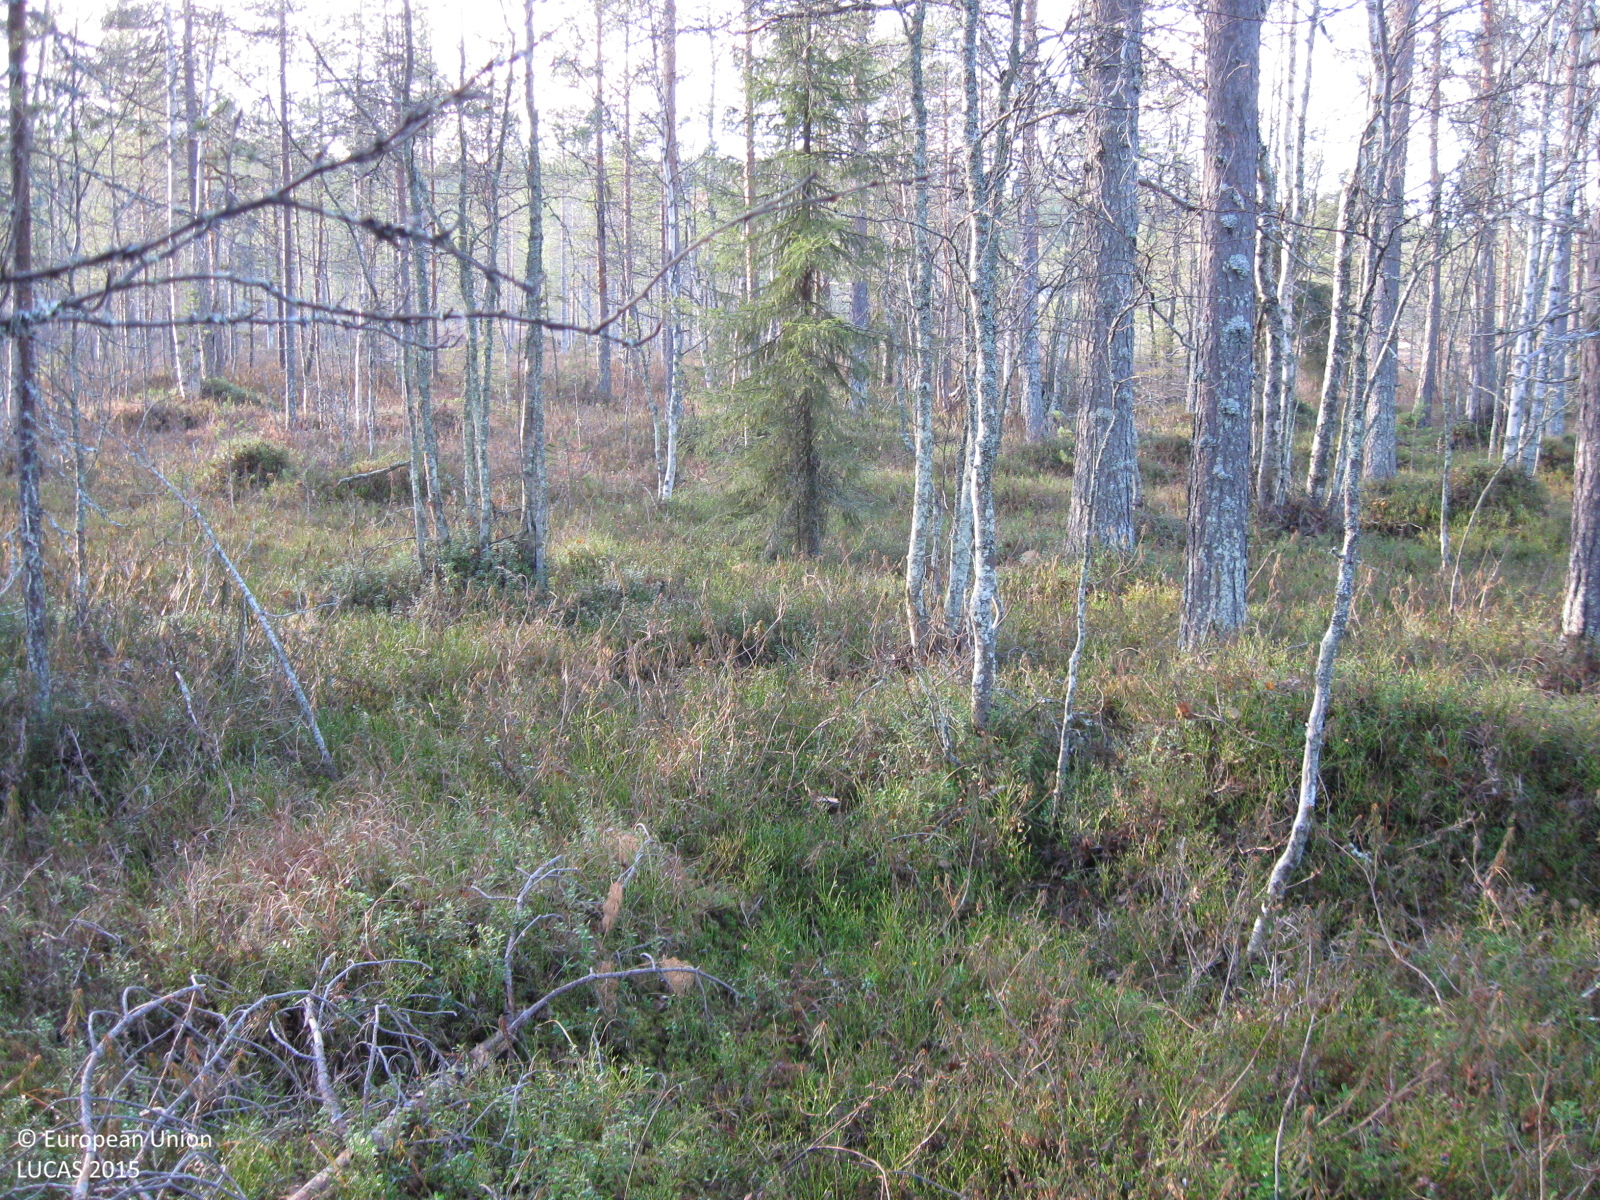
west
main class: Woodland
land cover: Pine dominated mixed woodland
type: boreal forest
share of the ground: > 75 %
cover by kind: coniferous forest trees 60 %, broadleaved forest trees 20 %, shrubs 10 %, herbaceous plants 5 %, lichens and mosses 5 %
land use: Forestry
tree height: > 5 m
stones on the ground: 10 - 25 %
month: October
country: SE
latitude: 66.2198
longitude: 22.1733
